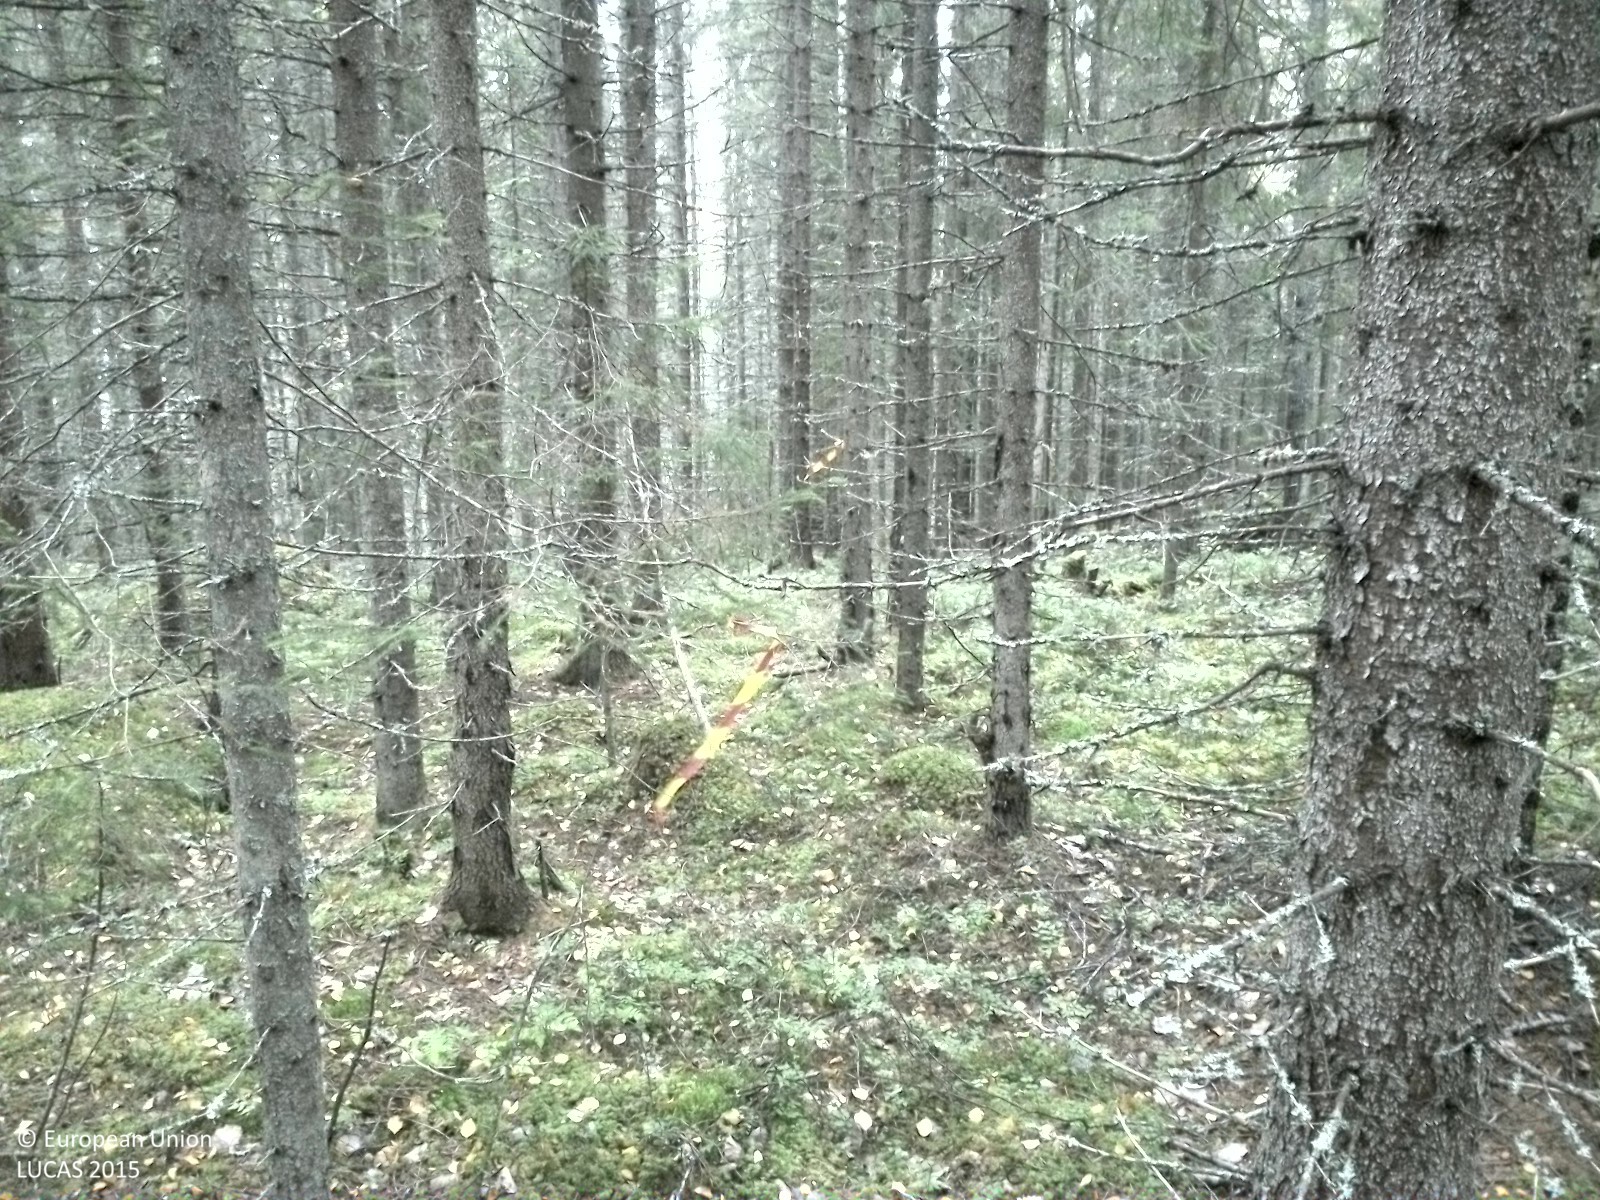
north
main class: Woodland
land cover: Spruce dominated coniferous woodland
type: boreal forest
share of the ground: > 75 %
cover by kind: coniferous forest trees 80 %, broadleaved forest trees 15 %, shrubs 5 %
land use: Forestry
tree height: > 5 m
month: September
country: SE
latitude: 62.4714
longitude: 16.5151
